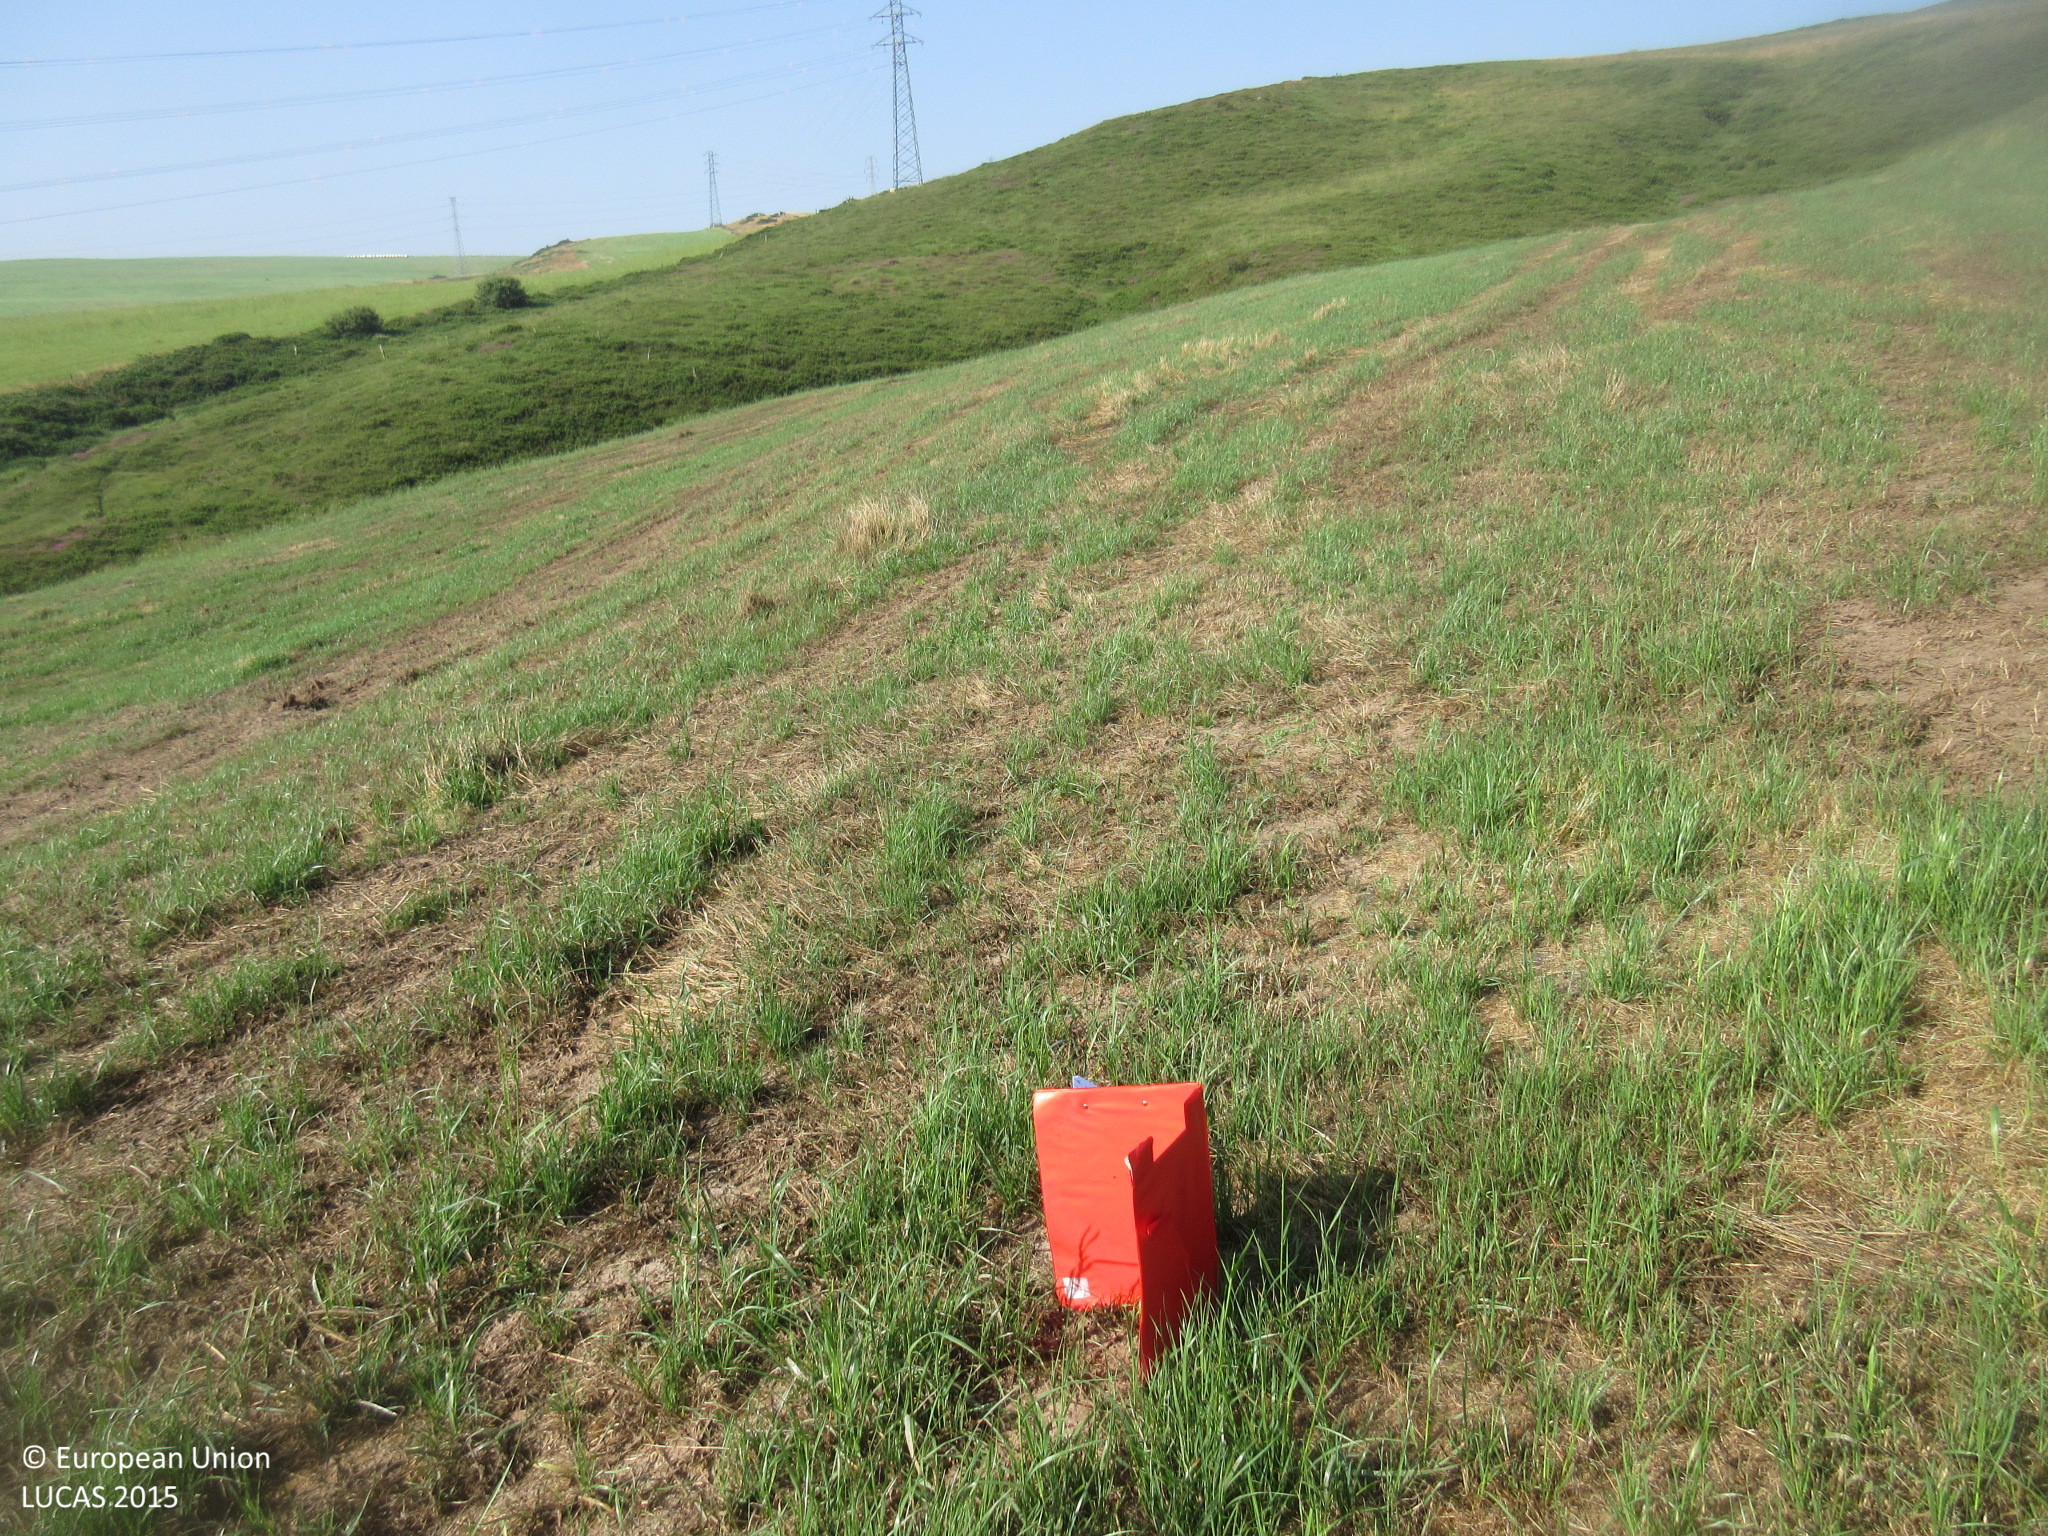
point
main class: Grassland
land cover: Grassland without tree/shrub cover
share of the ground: > 75 %
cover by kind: herbaceous plants 100 %
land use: Agriculture (excluding fallow land and kitchen gardens)
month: July
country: ES
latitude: 43.3557
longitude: -6.3486
